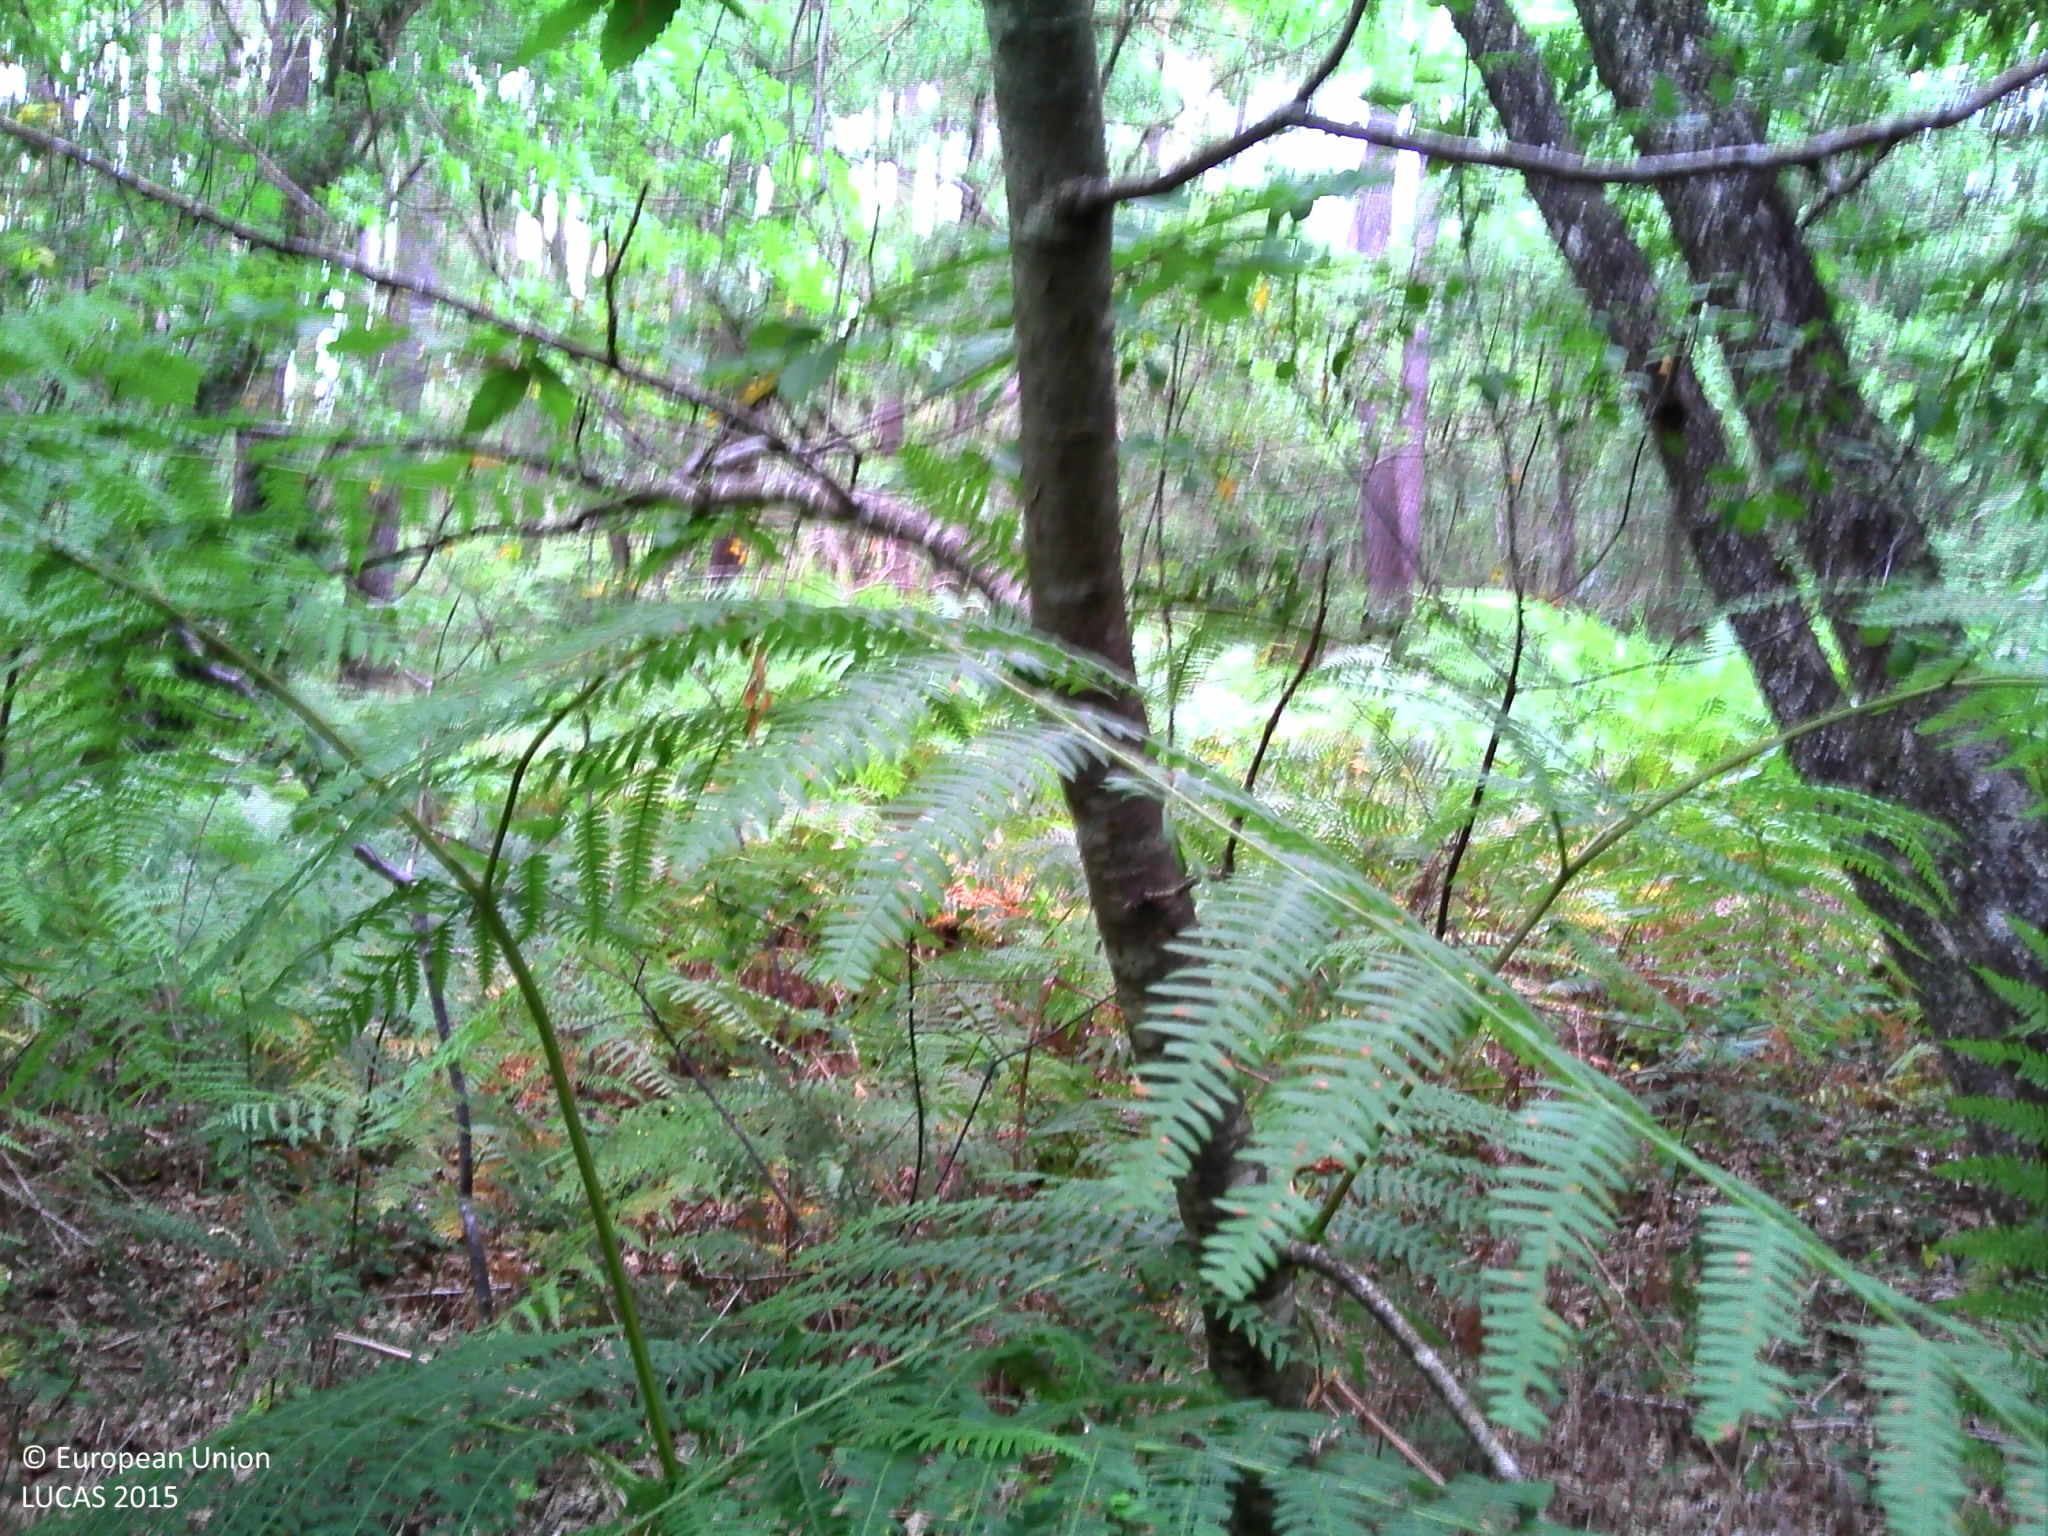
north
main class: Woodland
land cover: Broadleaved woodland
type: acidophilous oak and oak-birch forest
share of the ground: 50 - 75 %
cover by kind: broadleaved forest trees 75 %, herbaceous plants 15 %, shrubs 5 %, lichens and mosses 5 %
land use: Forestry
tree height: > 5 m
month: July
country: FR
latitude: 45.0821
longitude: 0.7807
